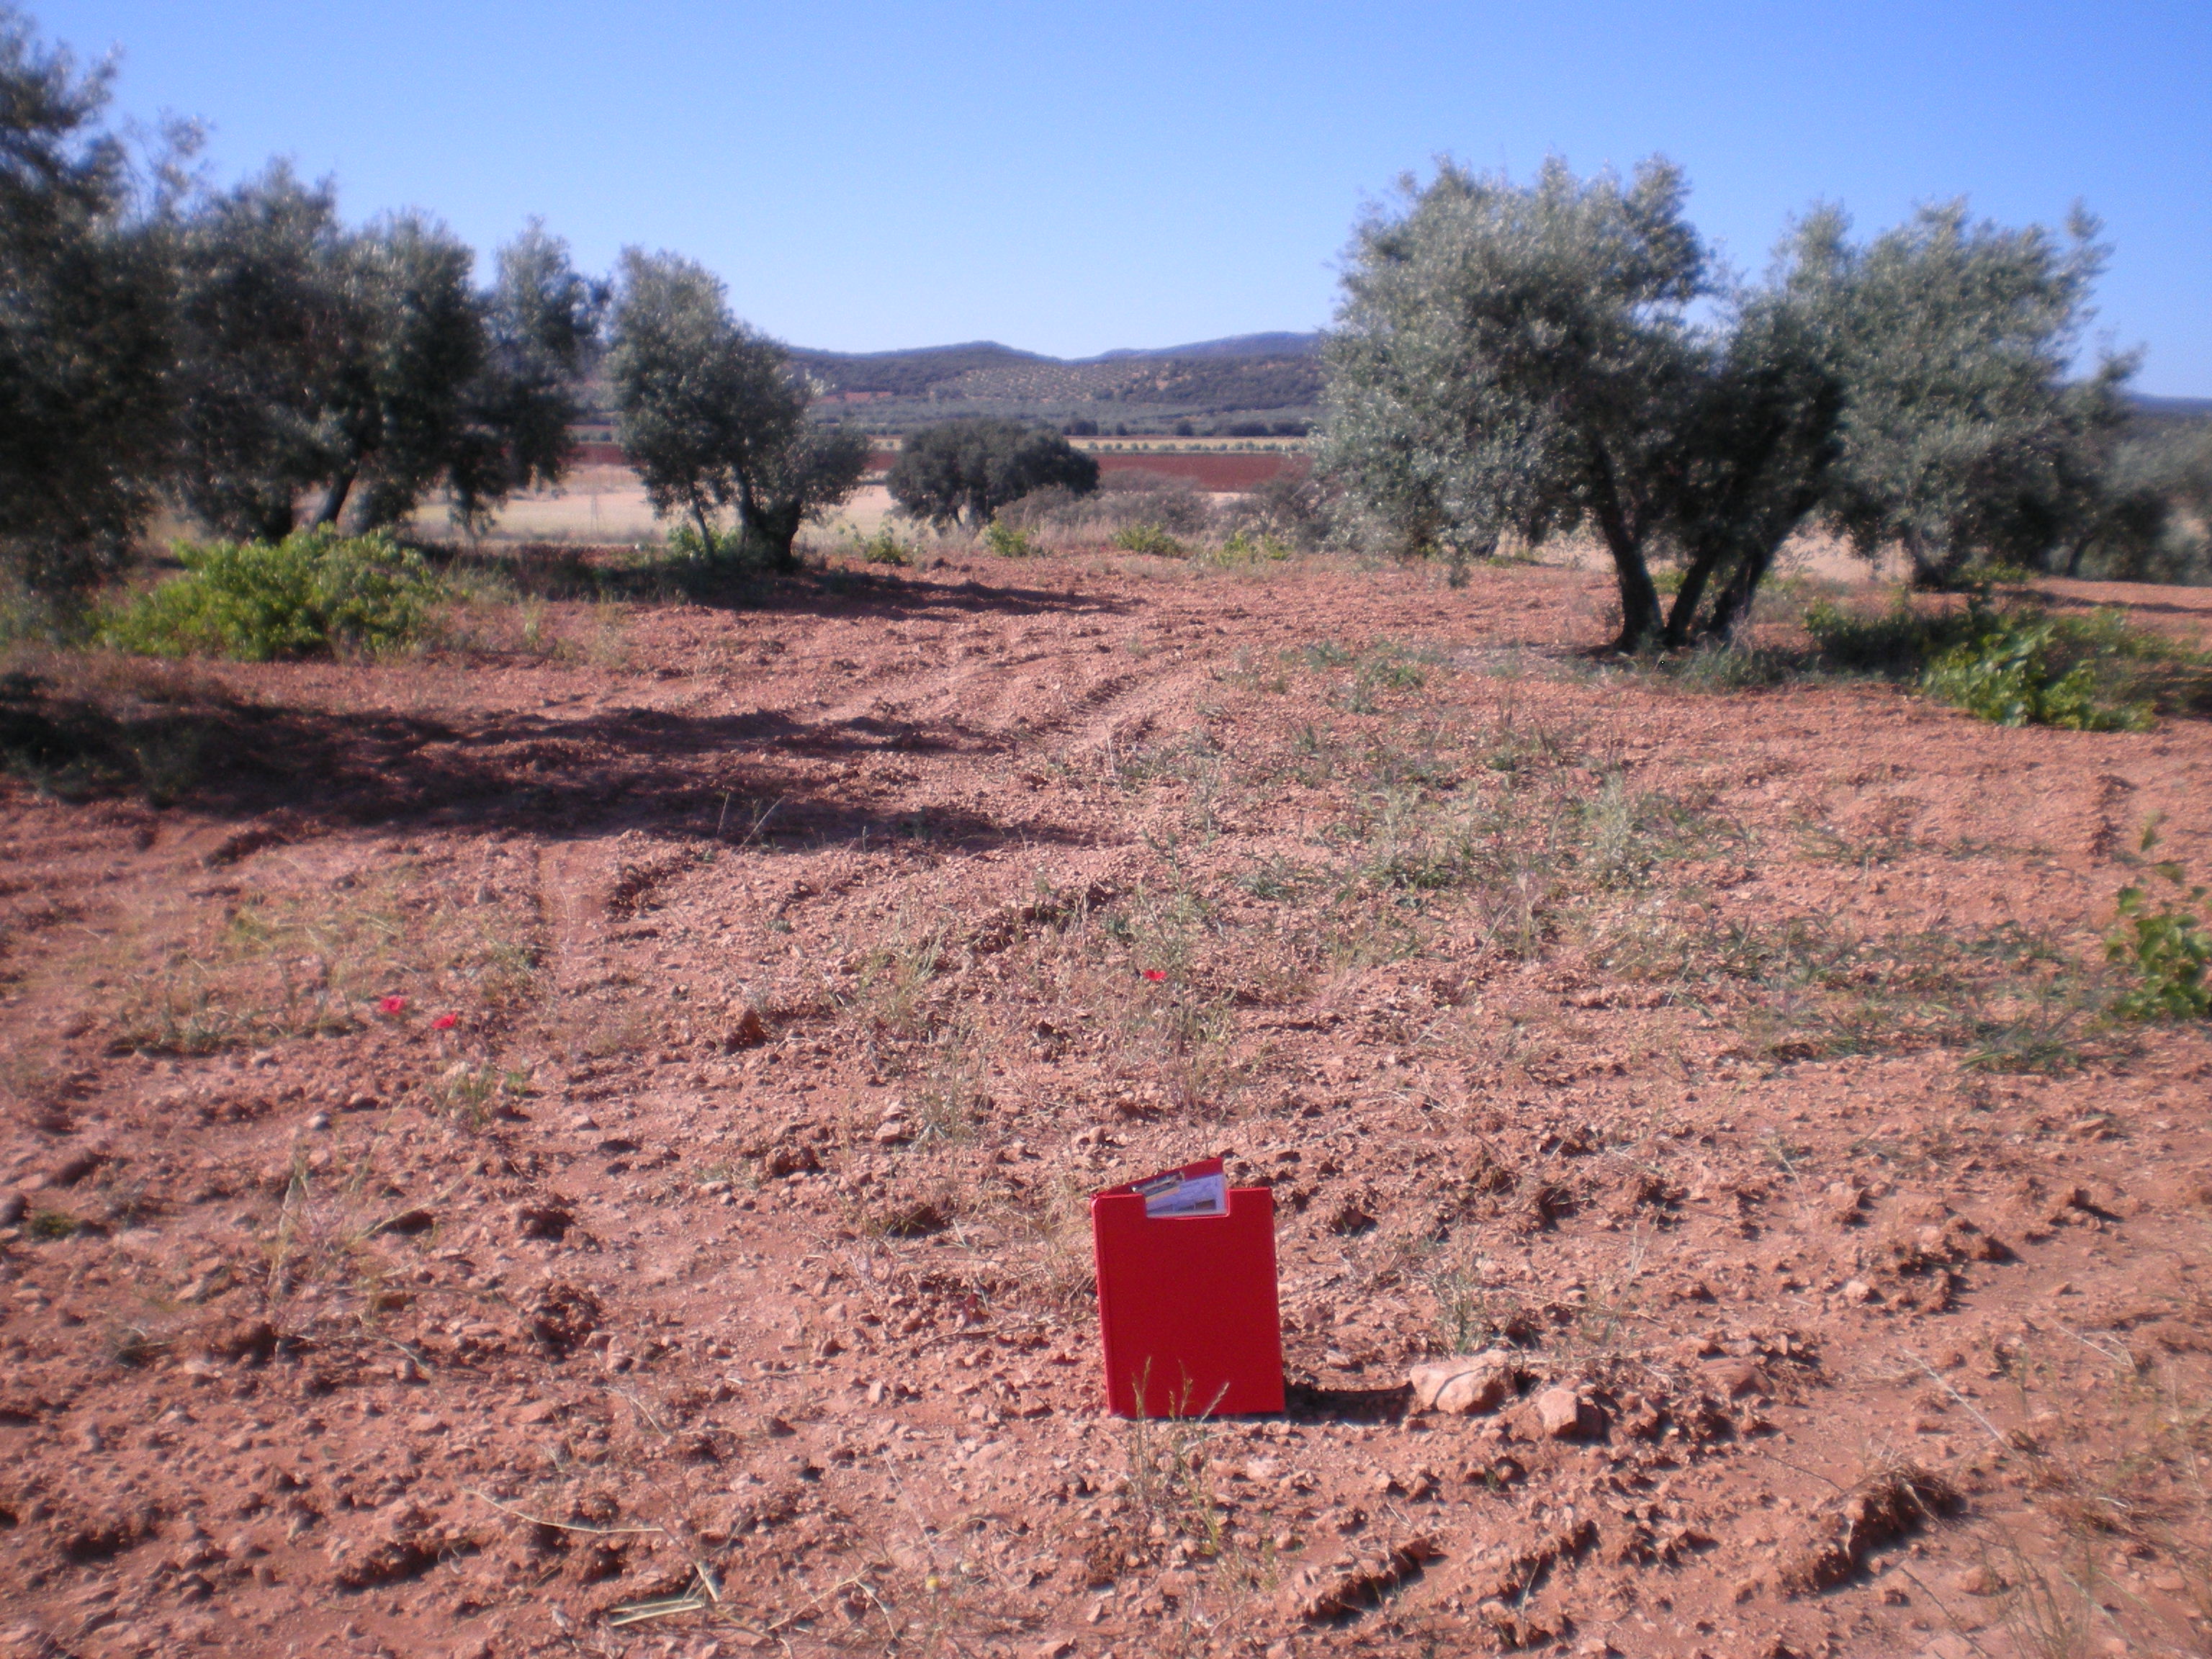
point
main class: Cropland
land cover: Olive groves
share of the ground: 10 - 25 %
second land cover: Spontaneously vegetated surfaces
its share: 10 - 25 %
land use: Agriculture (excluding fallow land and kitchen gardens)
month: May
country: ES
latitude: 38.5295
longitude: -3.3250
